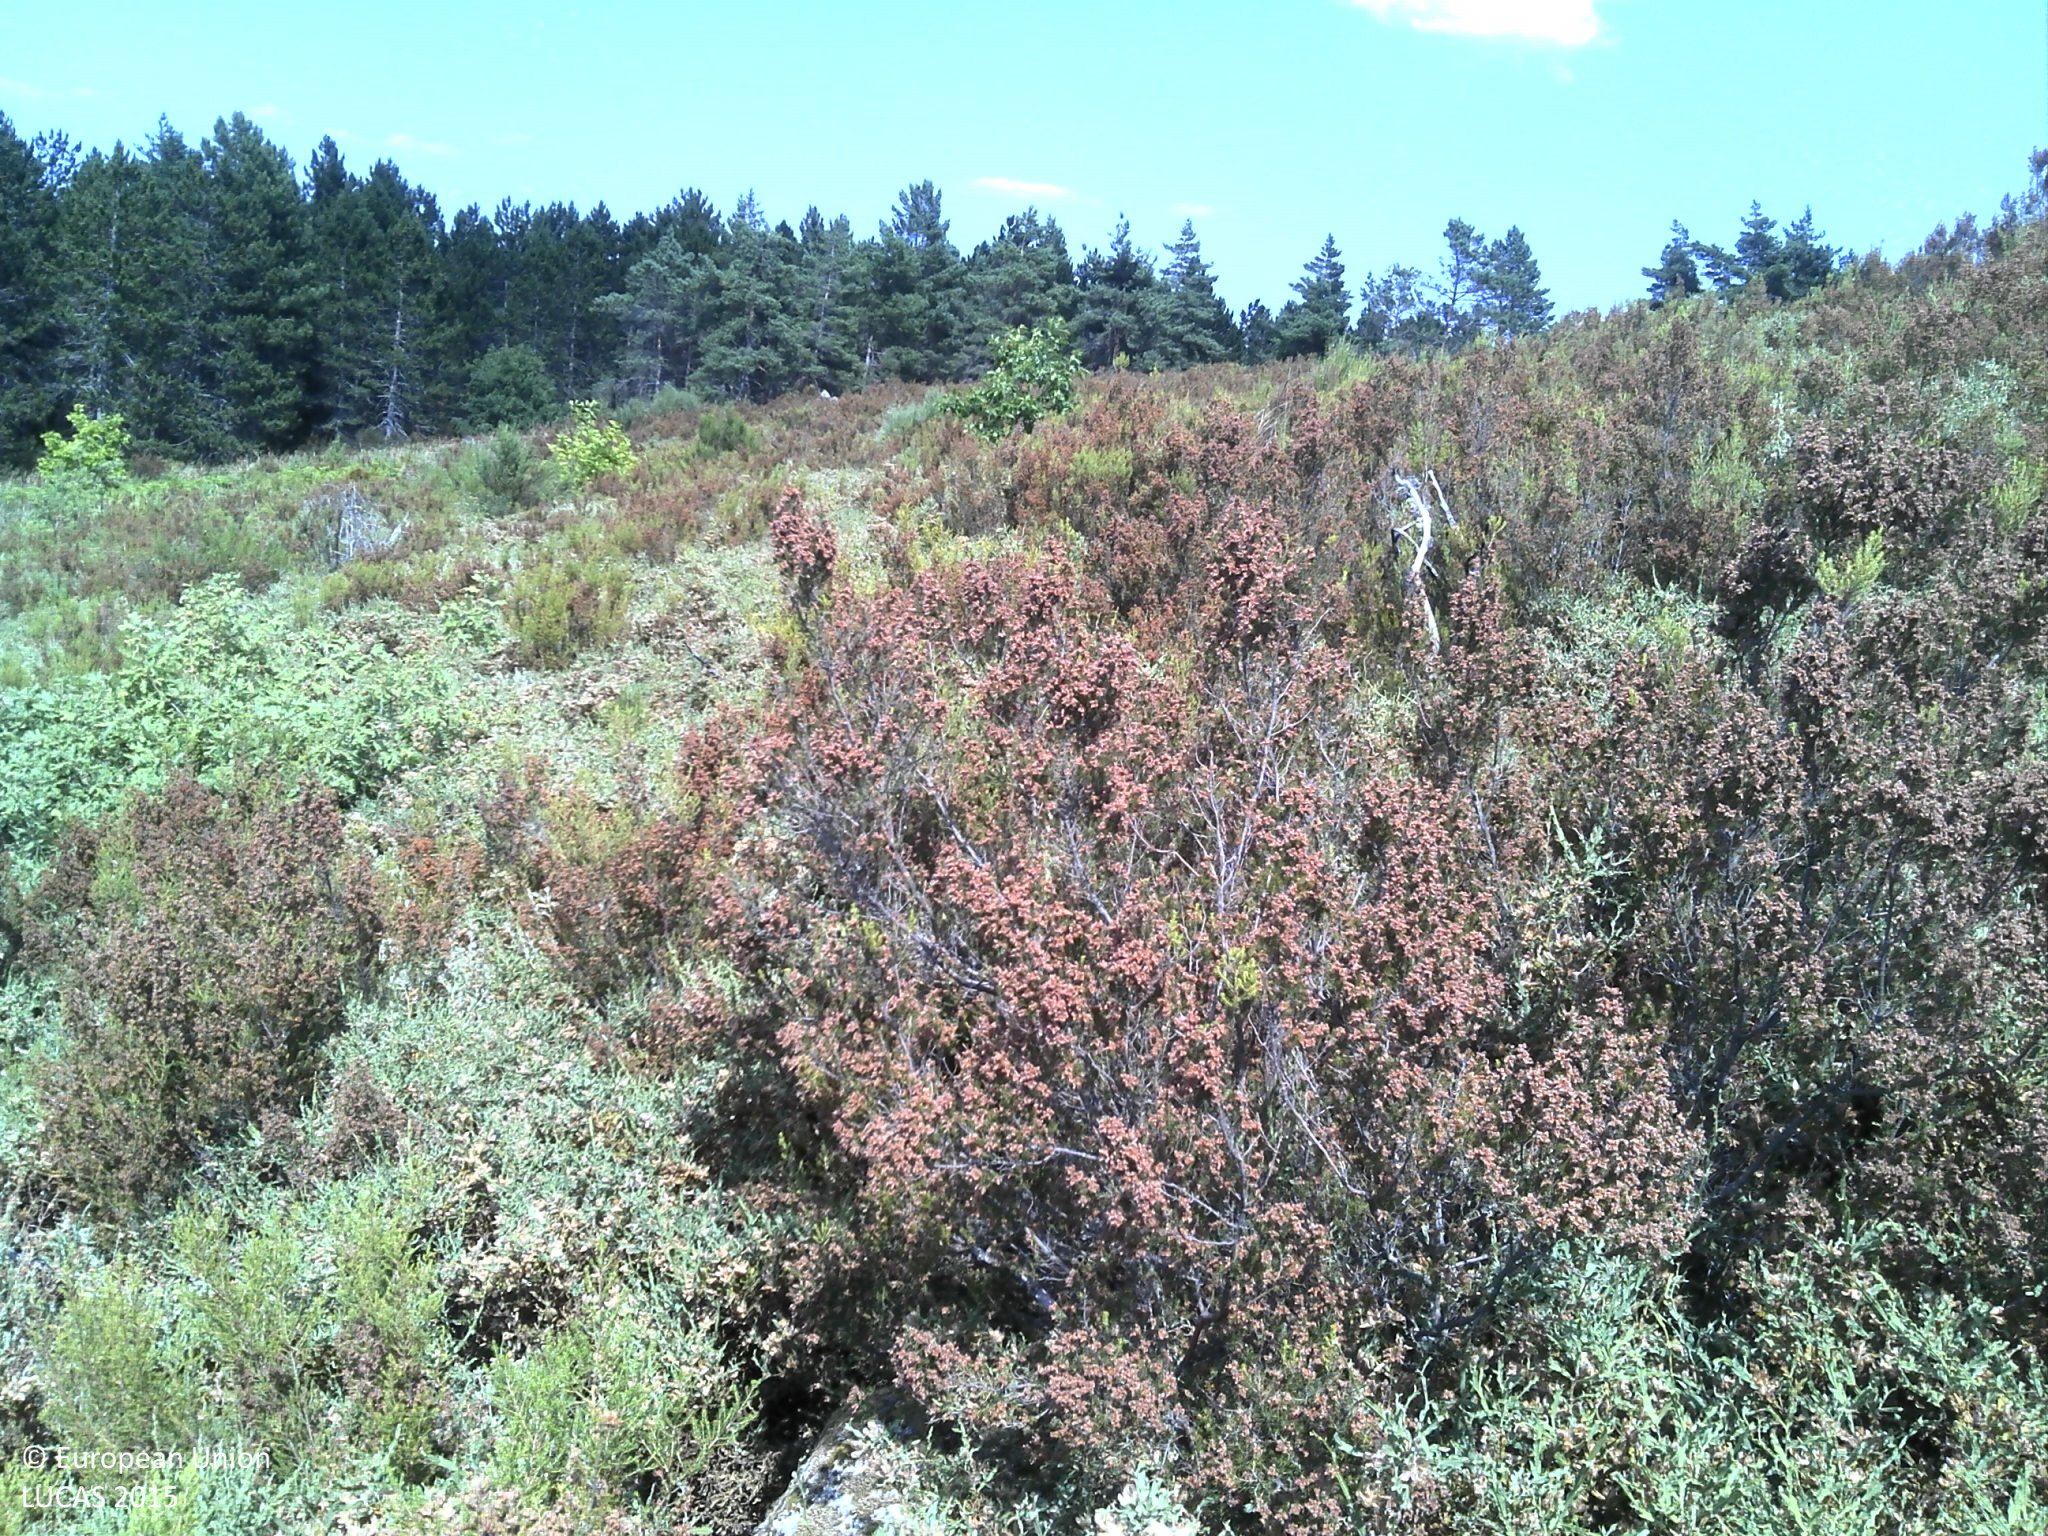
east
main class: Shrubland
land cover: Shrubland without tree cover
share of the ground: > 75 %
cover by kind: shrubs 90 %, consolidated bare surface 5 %, unconsolidated bare surface 5 %
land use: Semi-natural and natural areas not in use
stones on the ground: < 10 %
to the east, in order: Shrubland without tree cover; Tracks; Pine dominated coniferous woodland; Shrubland without tree cover; Single bushes/trees; Shrubland without tree cover
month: July
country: PT
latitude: 41.7968
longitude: -7.8193
